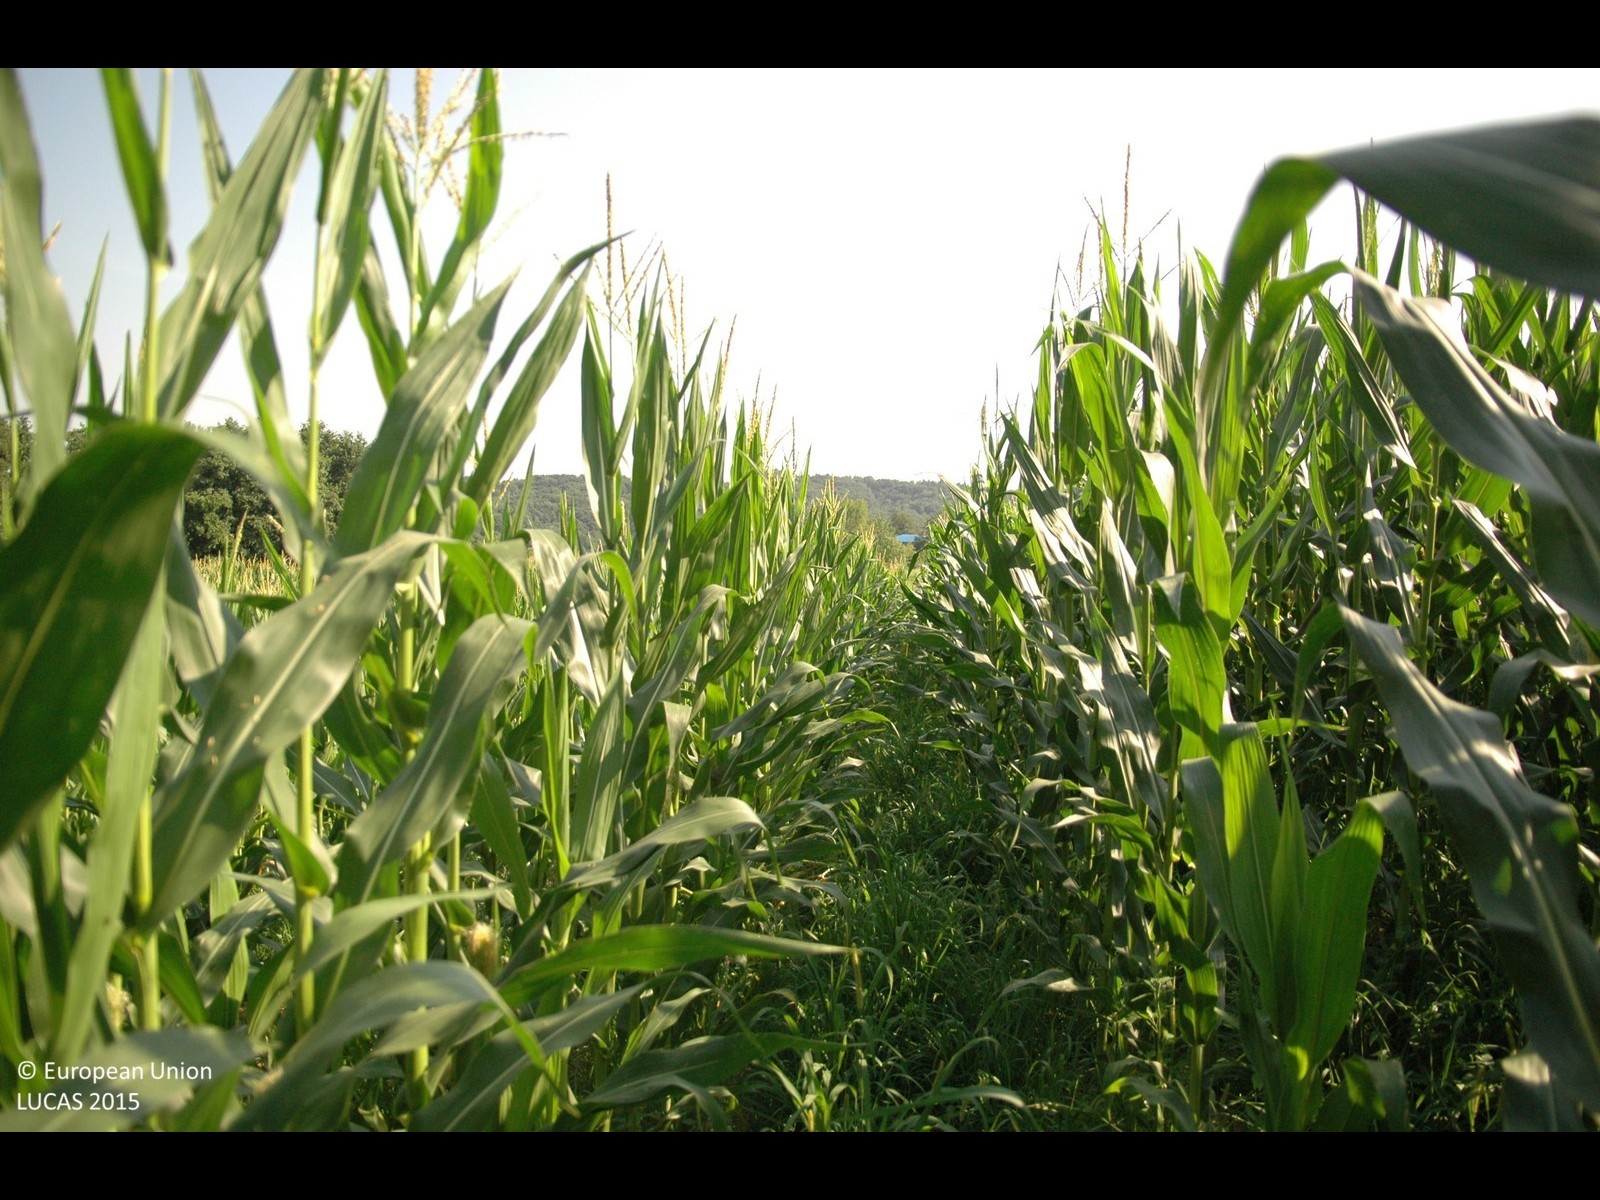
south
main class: Cropland
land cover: Maize
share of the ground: > 75 %
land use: Agriculture (excluding fallow land and kitchen gardens)
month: July
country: HR
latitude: 46.1838
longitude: 16.5948
